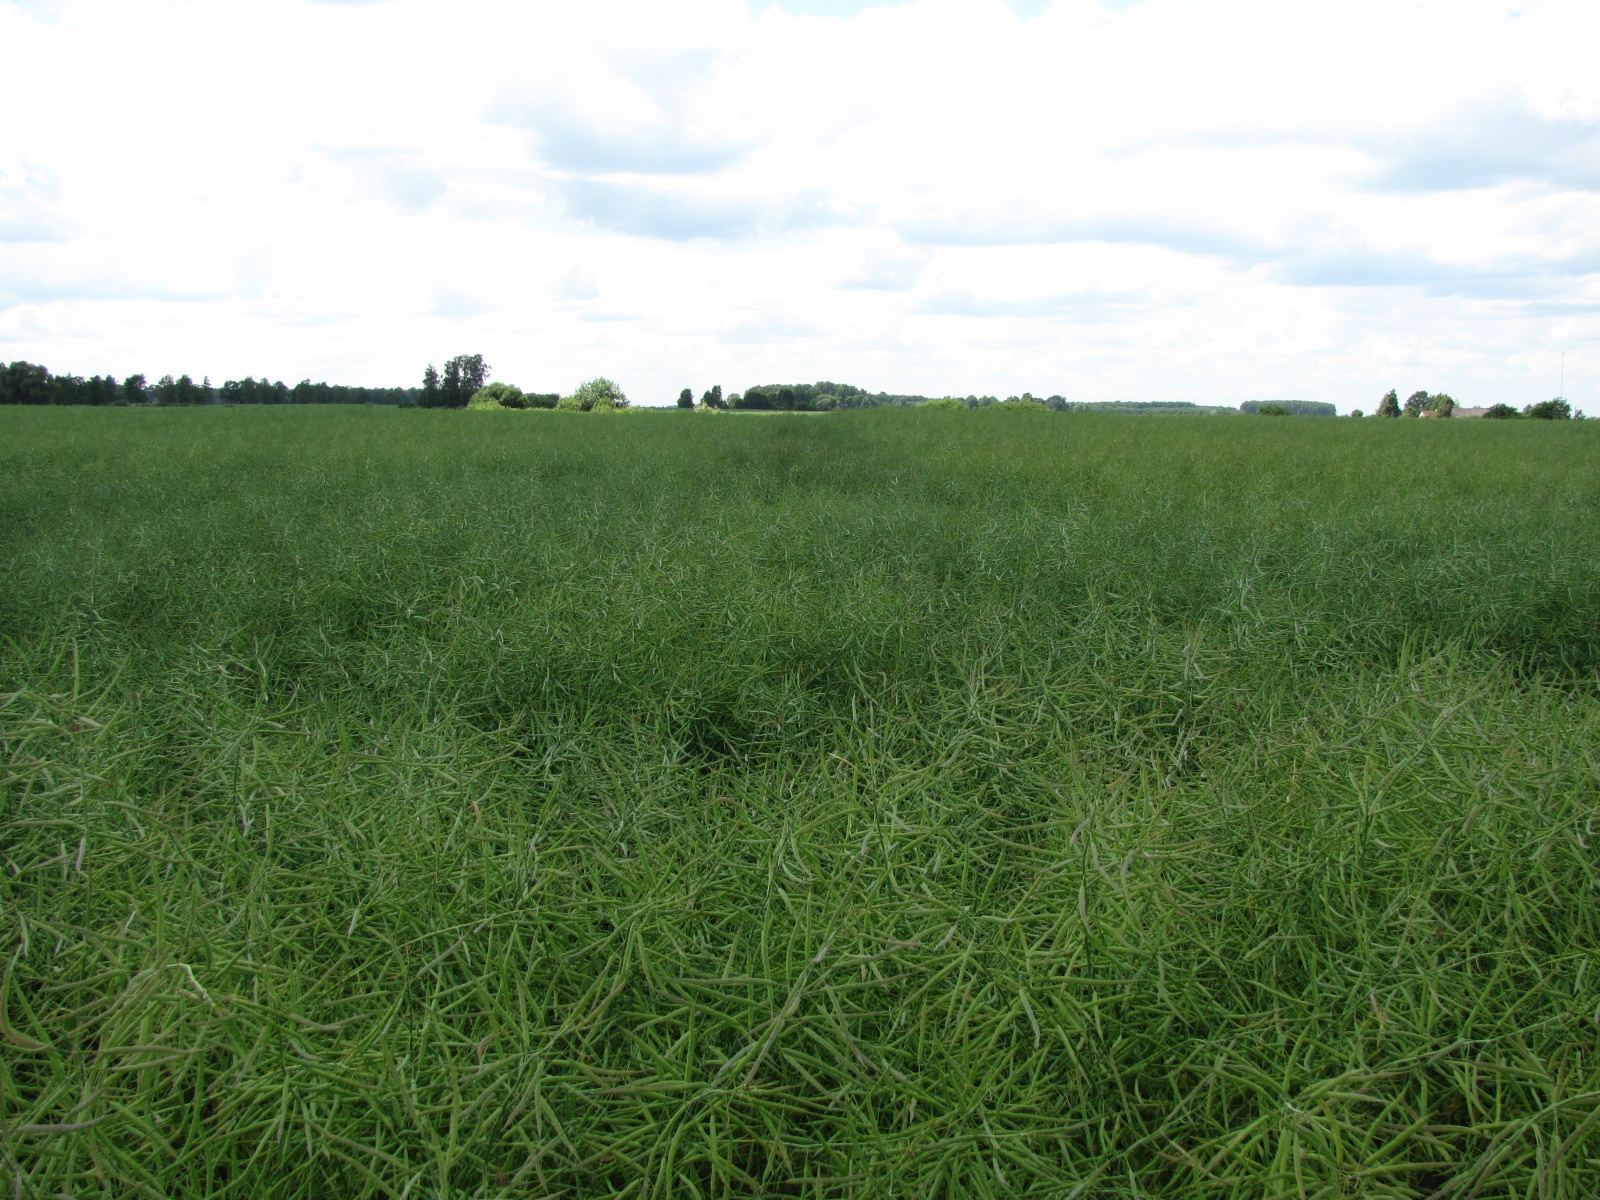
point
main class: Cropland
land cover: Rape and turnip rape
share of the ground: > 75 %
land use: Agriculture (excluding fallow land and kitchen gardens)
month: June
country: LV
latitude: 56.4298
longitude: 23.9154
